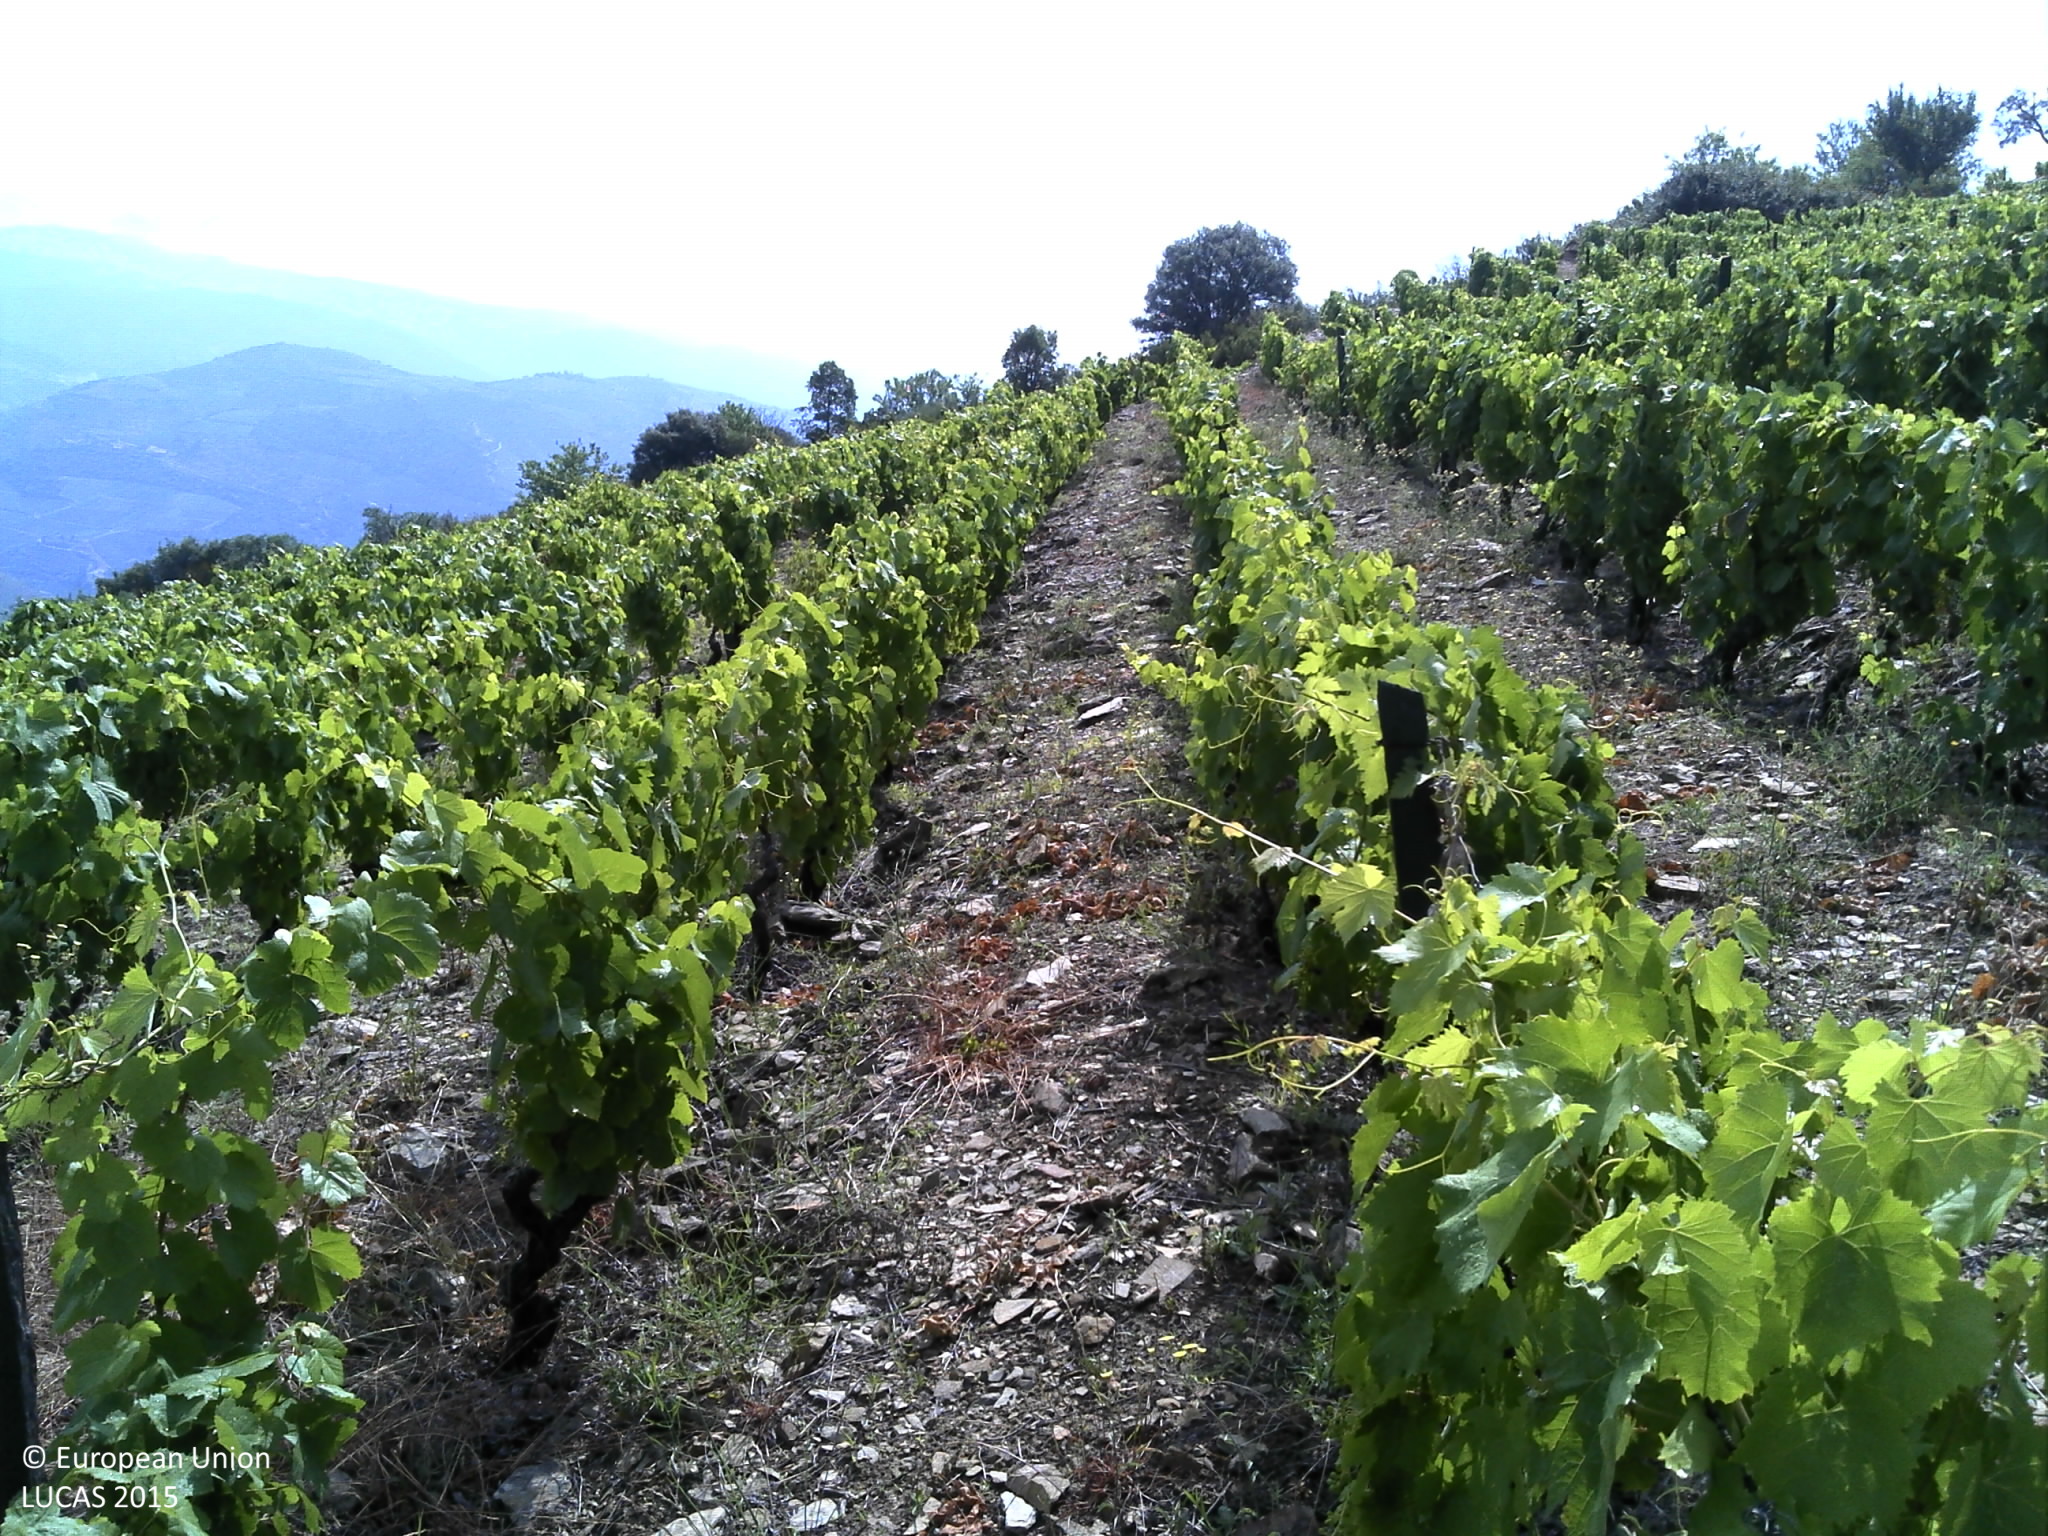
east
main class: Cropland
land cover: Vineyards
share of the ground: 10 - 25 %
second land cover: Spontaneously vegetated surfaces
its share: < 10 %
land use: Agriculture (excluding fallow land and kitchen gardens)
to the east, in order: Vineyards; Spontaneously vegetated surfaces; Shrubland with sparse tree cover; Tracks; Shrubland with sparse tree cover; Tracks; Shrubland with sparse tree cover; Tracks; Shrubland with sparse tree cover
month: June
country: PT
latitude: 41.1912
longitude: -7.4940
